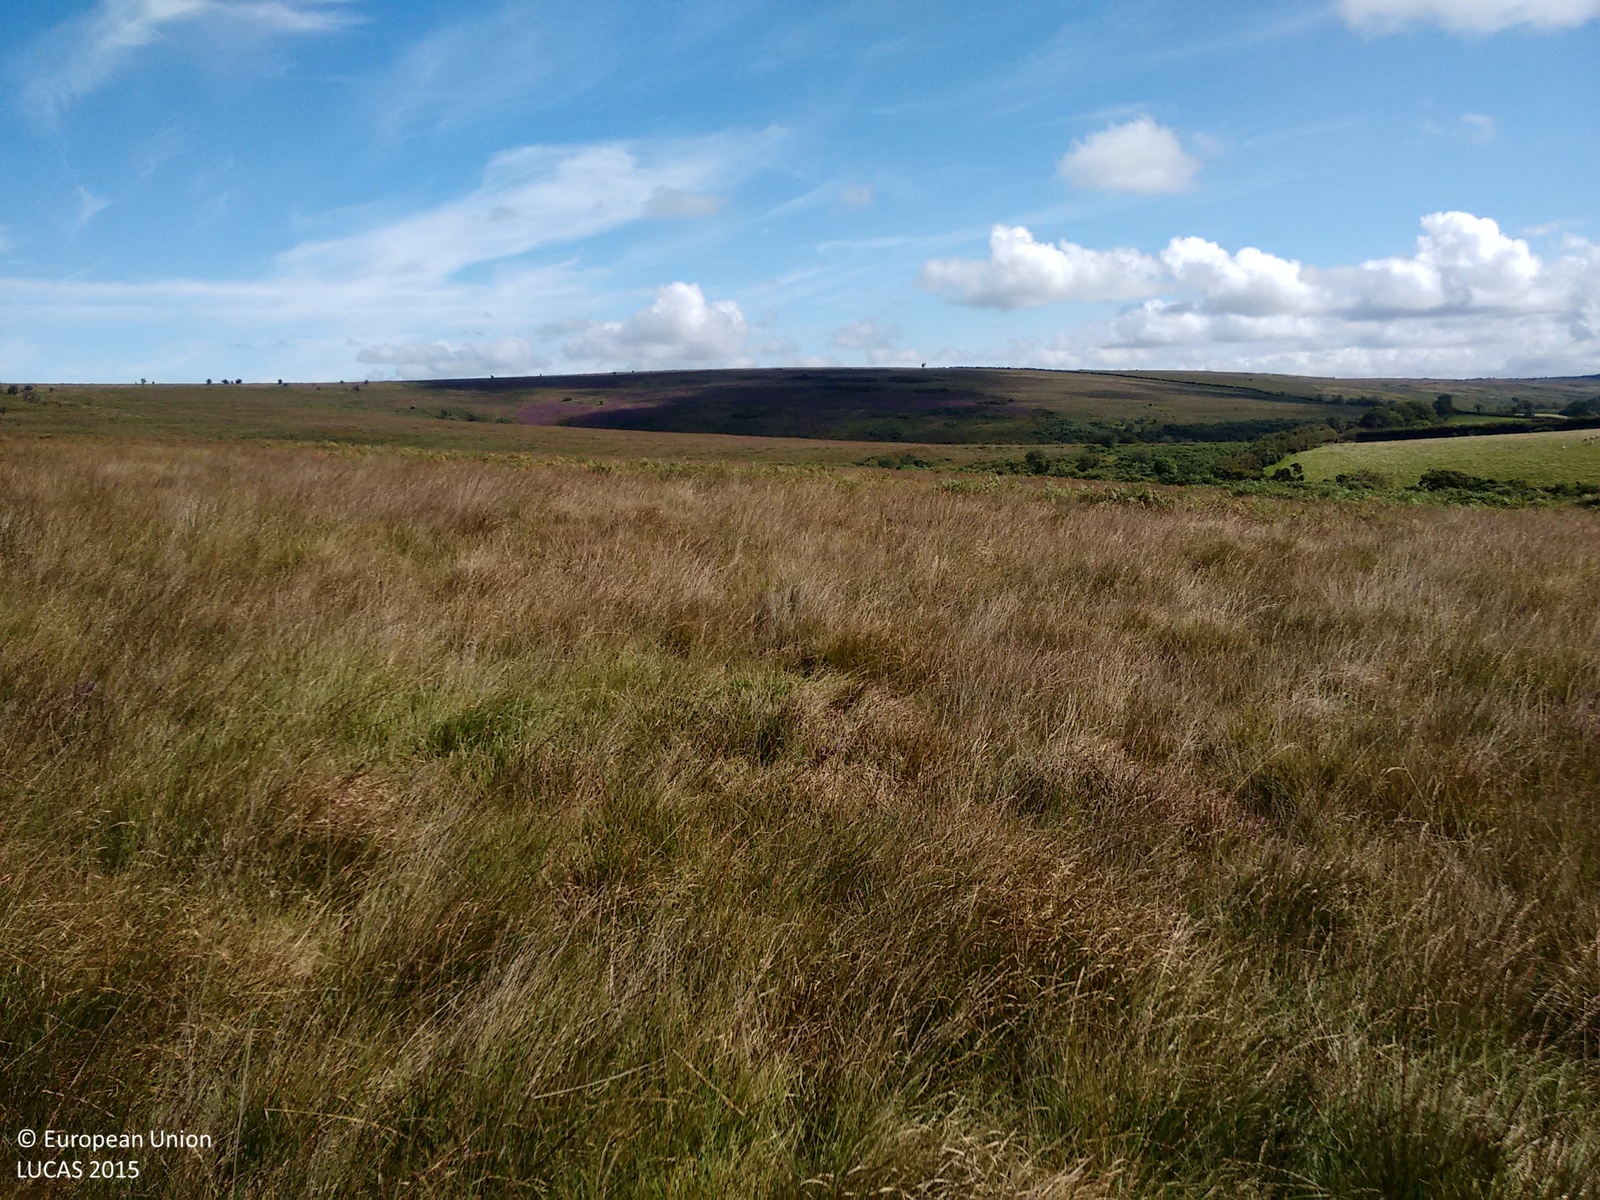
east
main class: Grassland
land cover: Grassland without tree/shrub cover
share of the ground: > 75 %
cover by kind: herbaceous plants 95 %, shrubs 5 %
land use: Agriculture (excluding fallow land and kitchen gardens)
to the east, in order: Grassland without tree/shrub cover; Grassland with sparse tree/shrub cover; Shrubland without tree cover; Grassland with sparse tree/shrub cover; Shrubland without tree cover; Tracks; Grassland without tree/shrub cover; Rivers and streams; Abandoned hedges; Fences; Grassland without tree/shrub cover
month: September
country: GB
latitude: 51.0511
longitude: -3.6828
